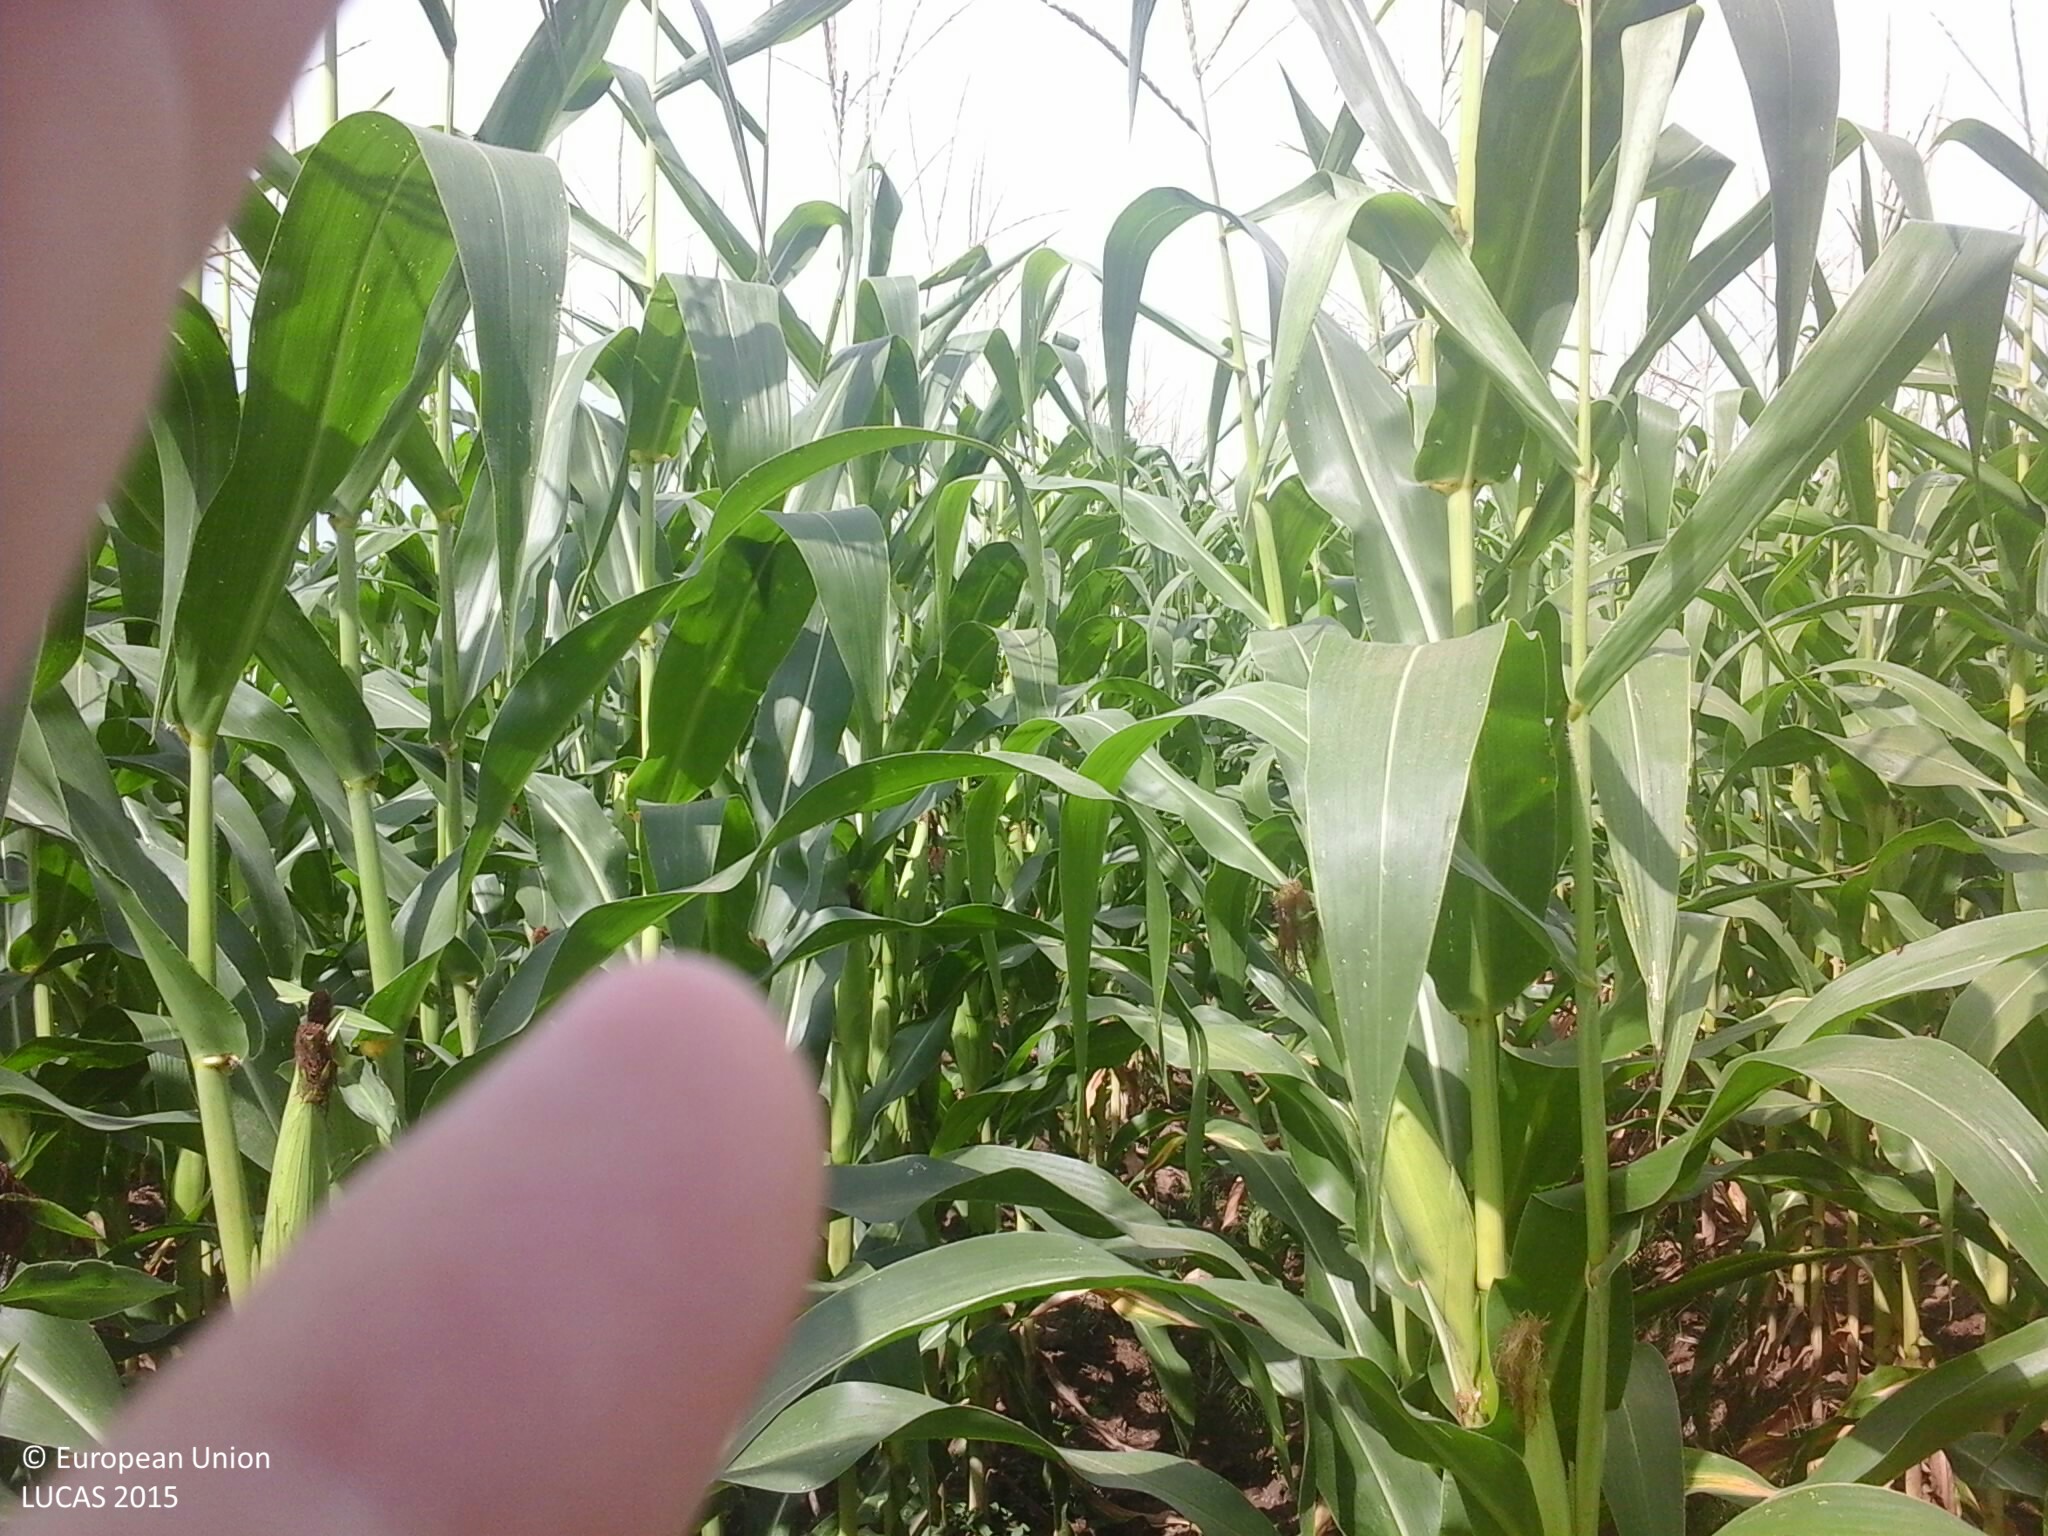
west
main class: Cropland
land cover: Maize
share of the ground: > 75 %
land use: Agriculture (excluding fallow land and kitchen gardens)
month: July
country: HU
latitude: 48.2801
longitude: 22.2797
